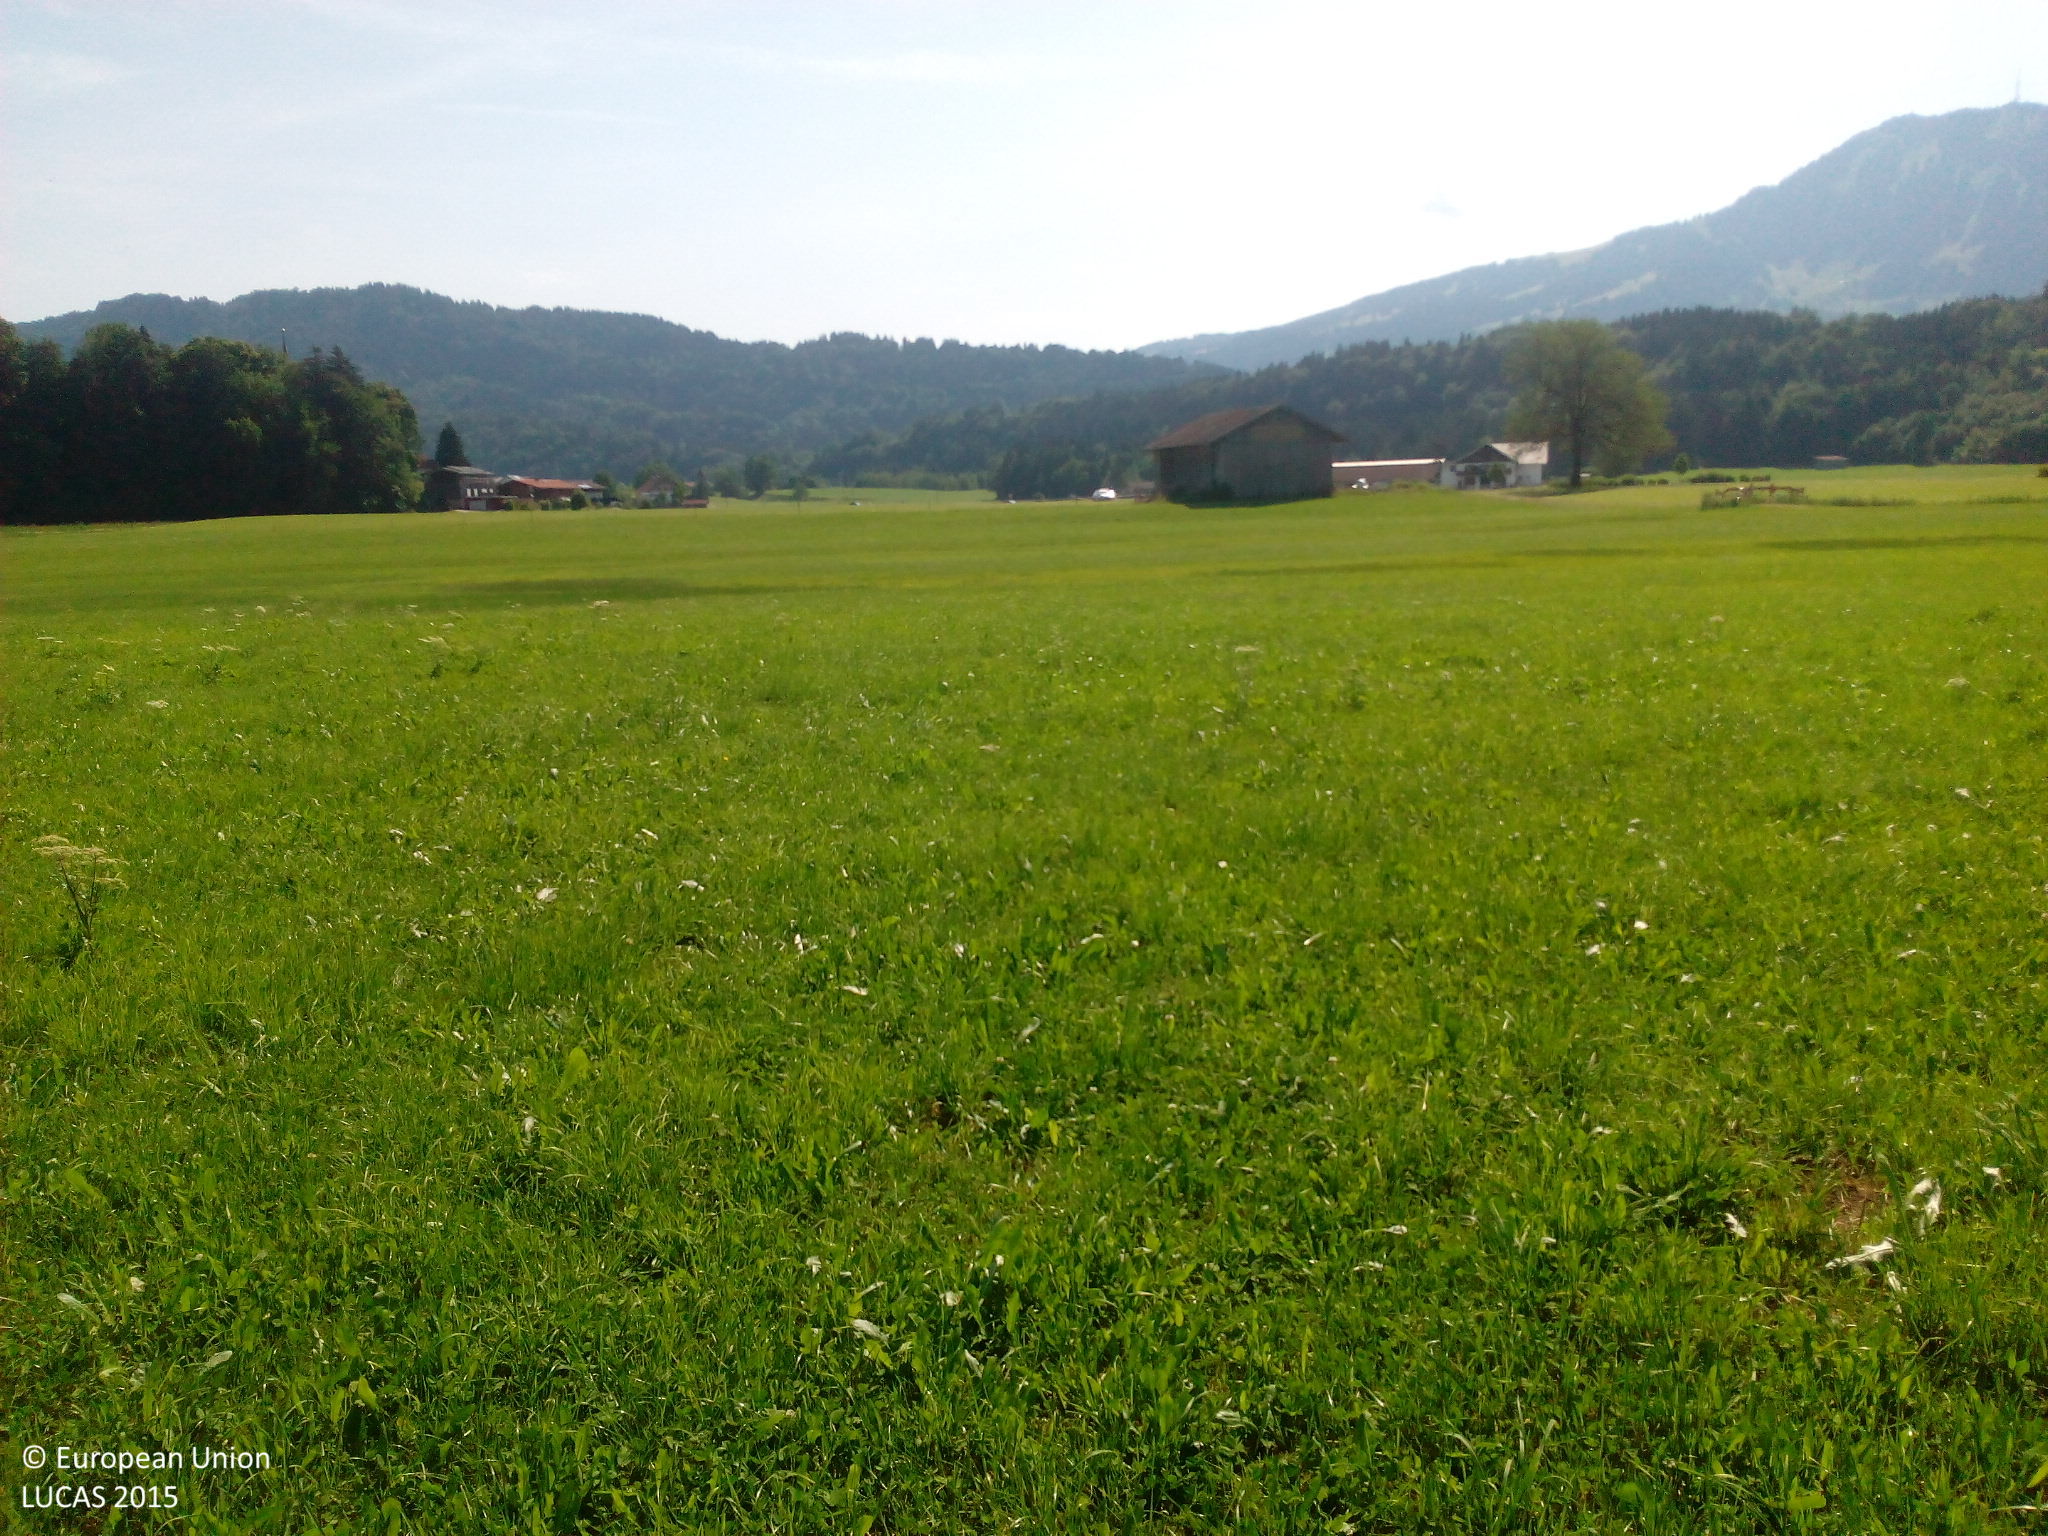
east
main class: Grassland
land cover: Grassland without tree/shrub cover
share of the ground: > 75 %
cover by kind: herbaceous plants 100 %
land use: Agriculture (excluding fallow land and kitchen gardens)
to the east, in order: Grassland without tree/shrub cover; Ditches and canals; Grassland without tree/shrub cover; Artificial constructions in urban areas; Grassland without tree/shrub cover; Tracks; Grassland without tree/shrub cover
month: July
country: DE
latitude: 47.5753
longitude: 10.2524
